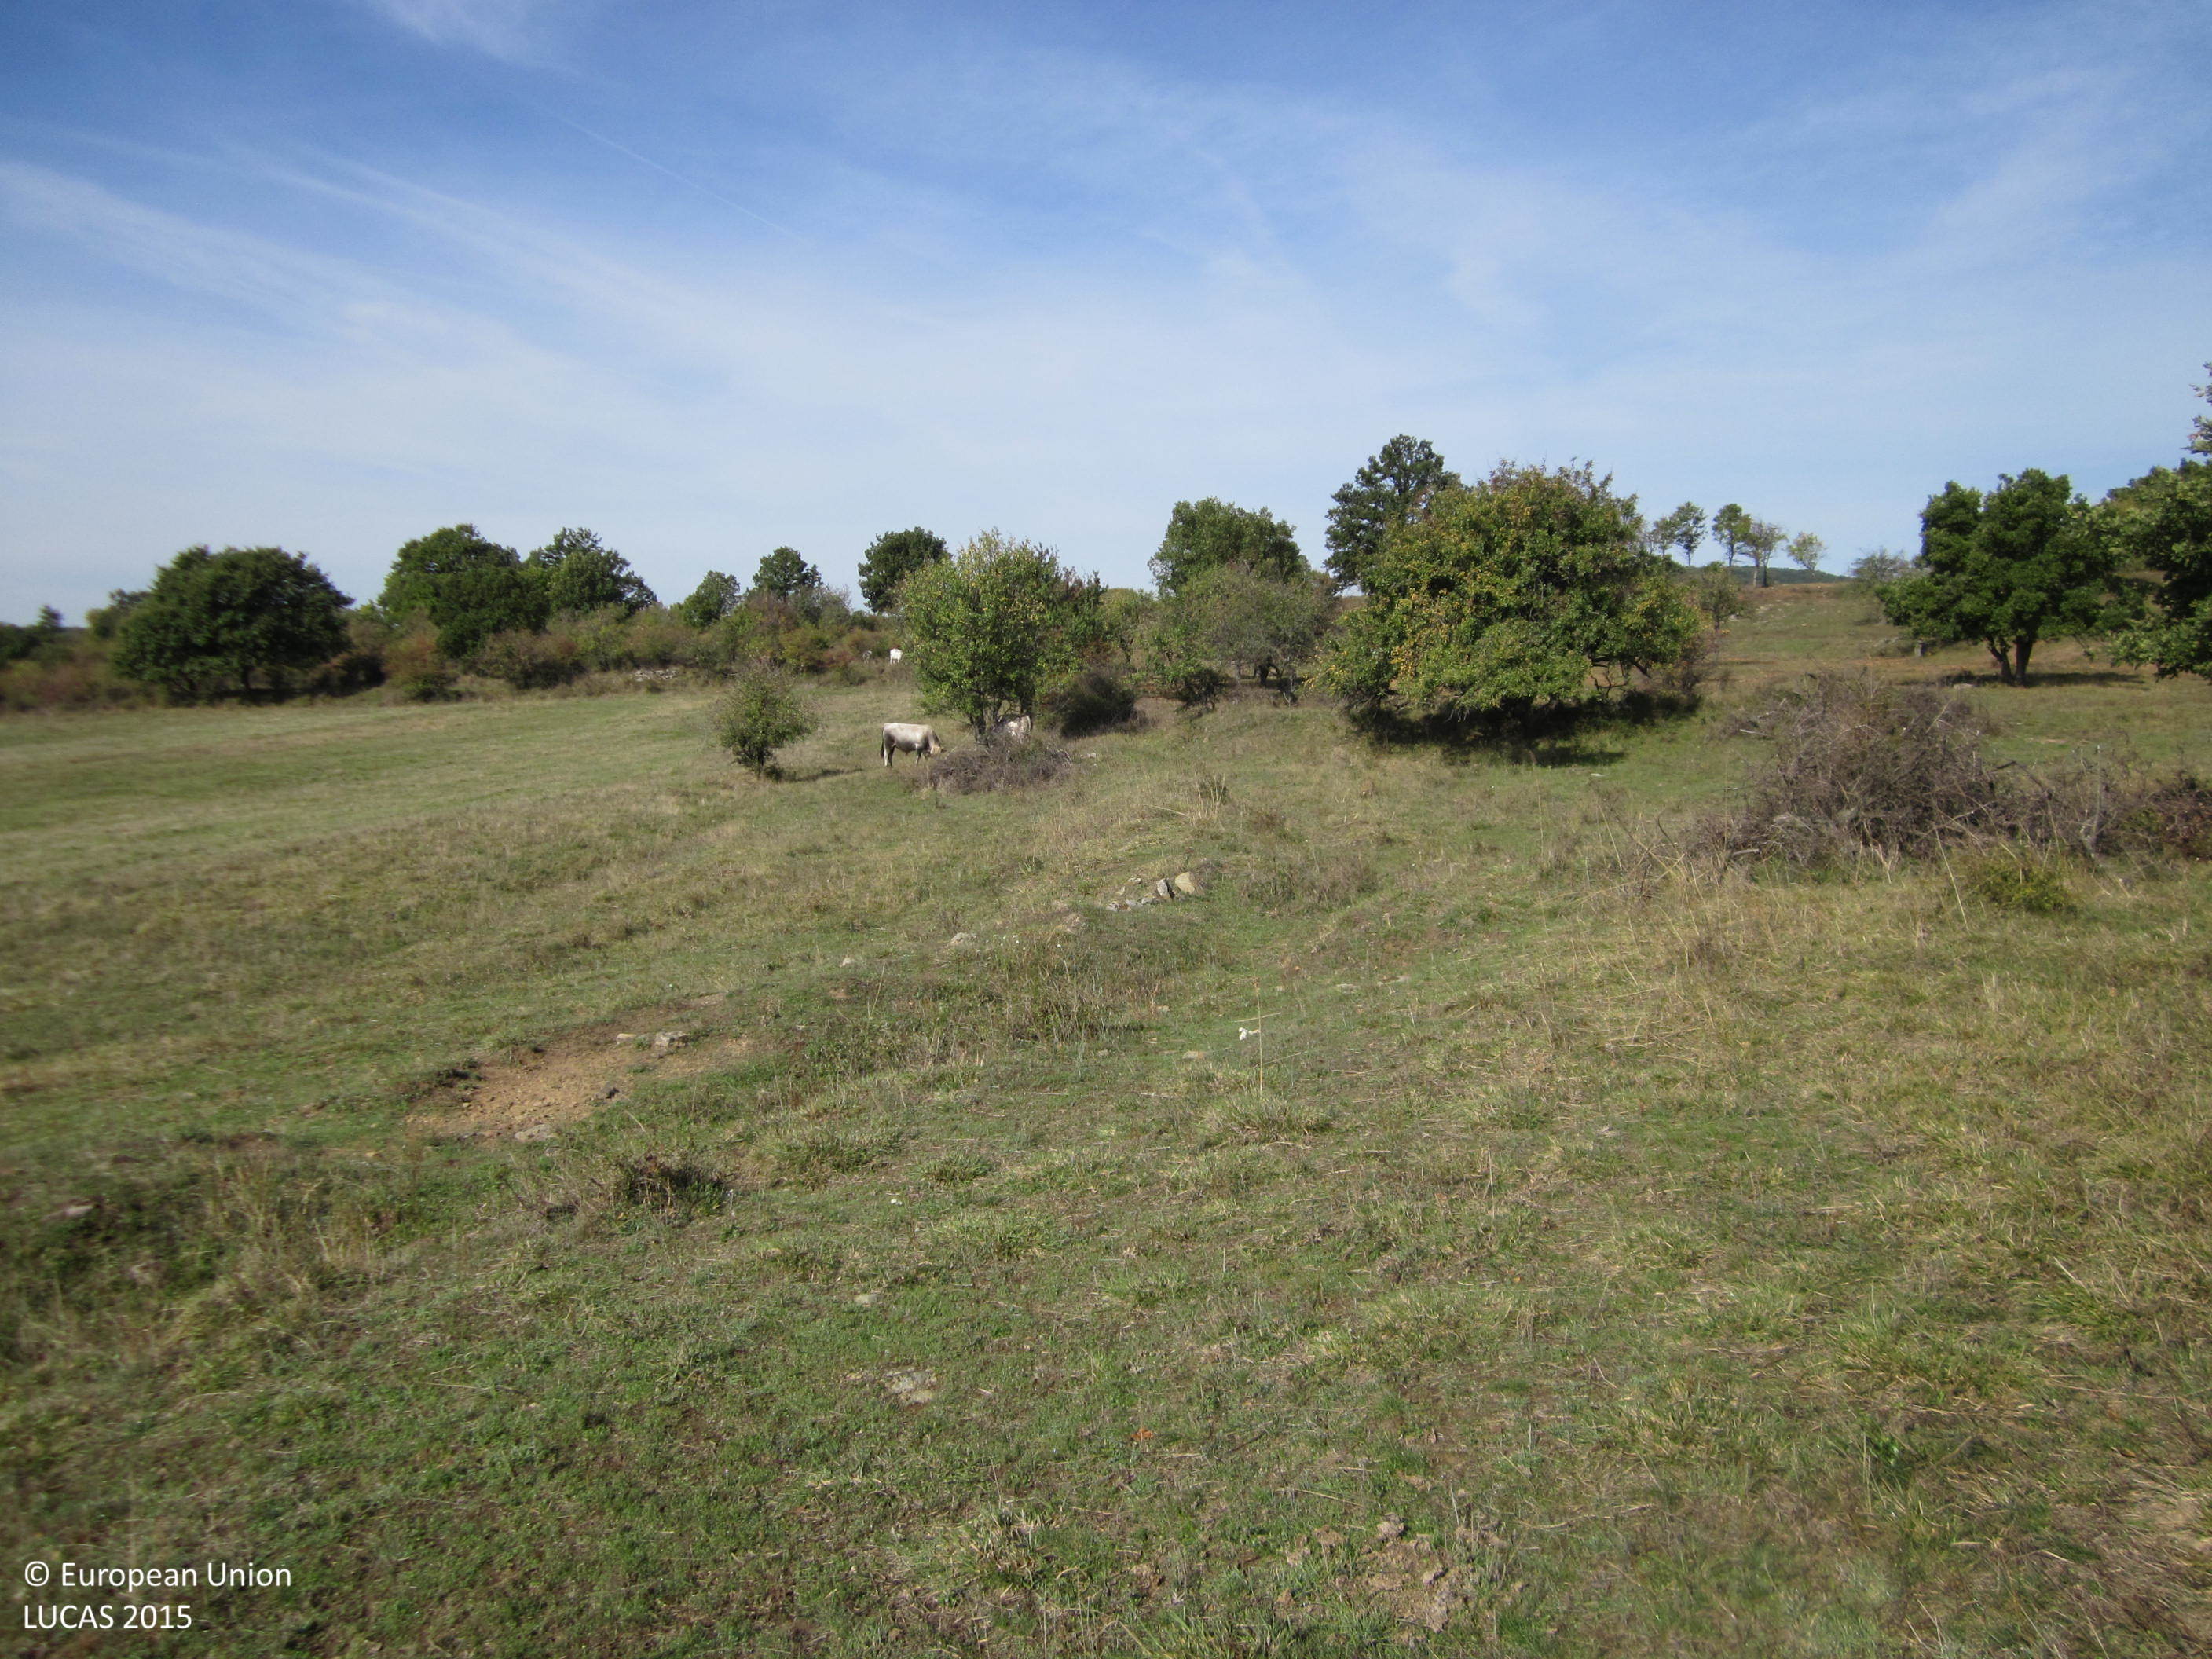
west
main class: Grassland
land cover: Grassland with sparse tree/shrub cover
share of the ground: > 75 %
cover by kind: herbaceous plants 90 %, broadleaved forest trees 5 %, shrubs 5 %
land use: Agriculture (excluding fallow land and kitchen gardens)
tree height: > 5 m
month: October
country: BG
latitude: 42.8768
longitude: 26.6901
